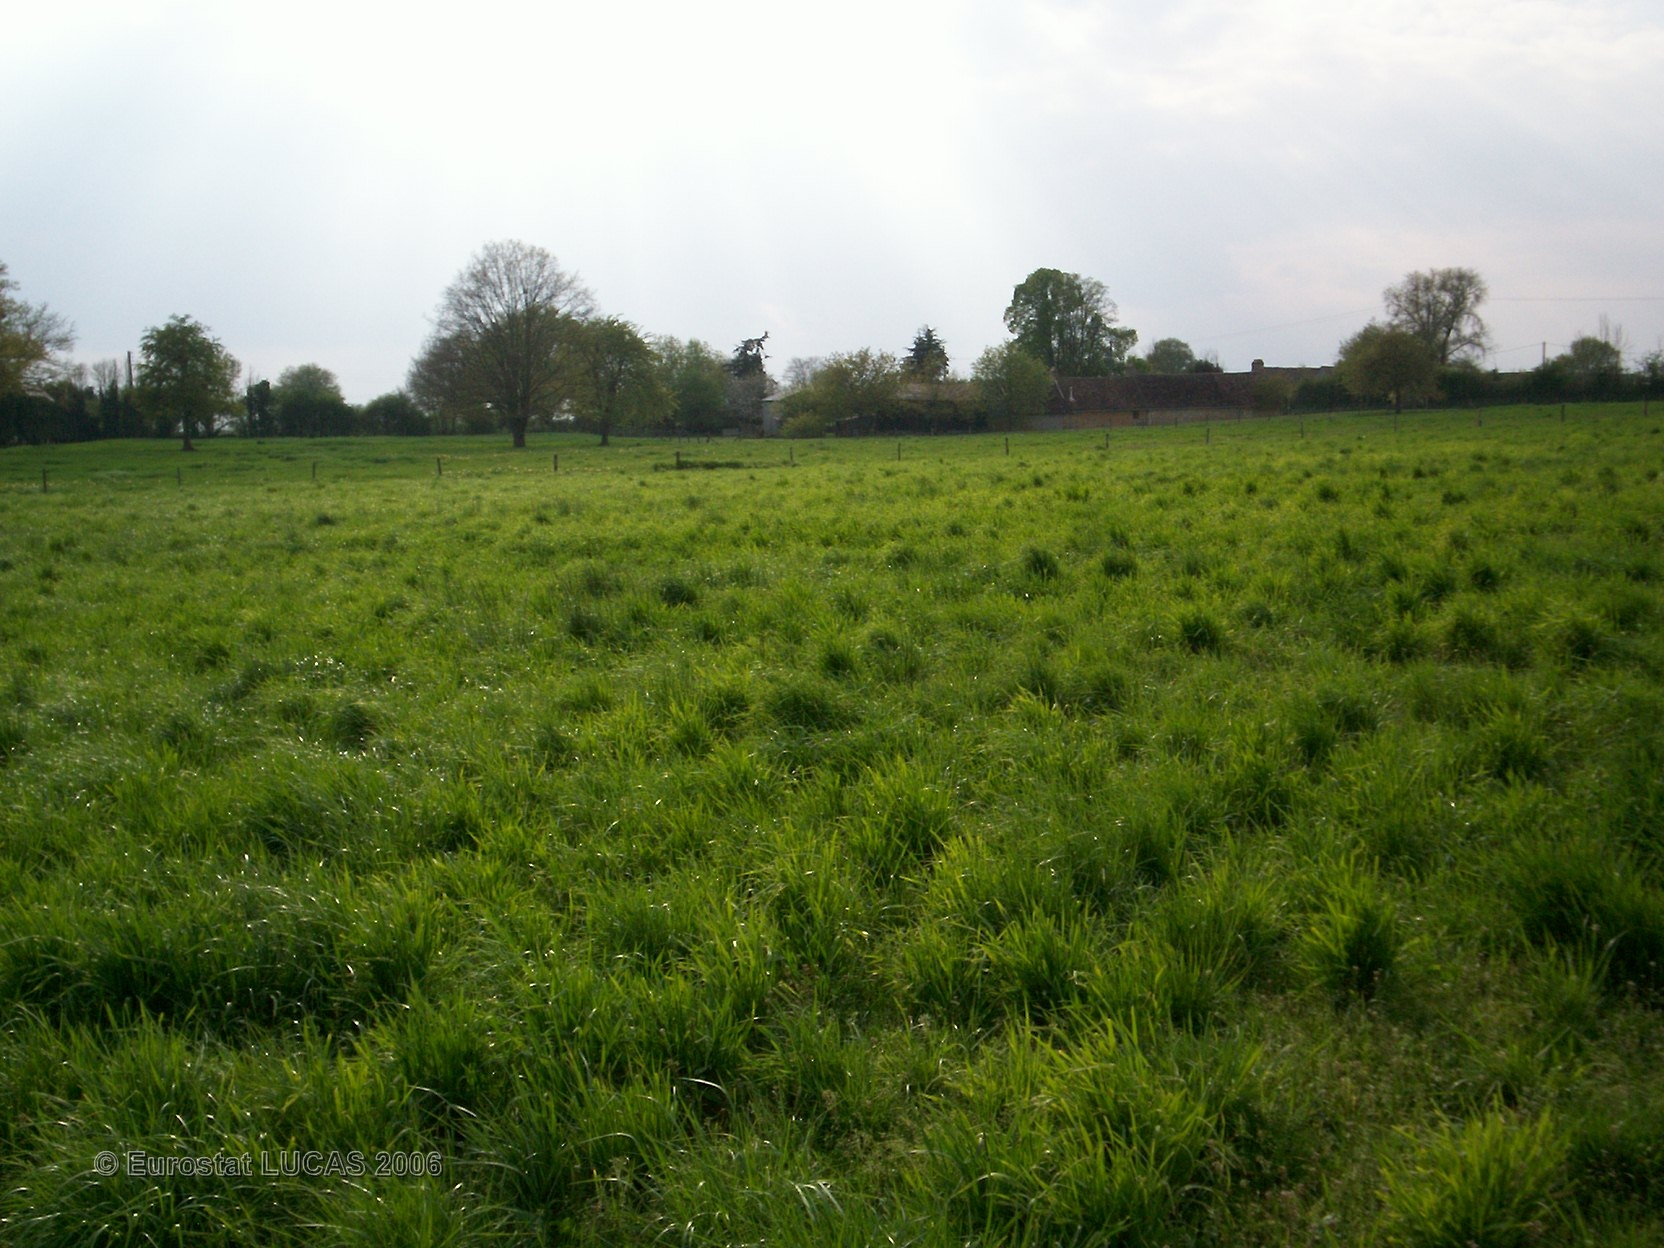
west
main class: Grassland
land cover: Grassland without tree/shrub cover
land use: Agriculture (excluding fallow land and kitchen gardens)
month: April
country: FR
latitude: 47.9138
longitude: -0.1852
